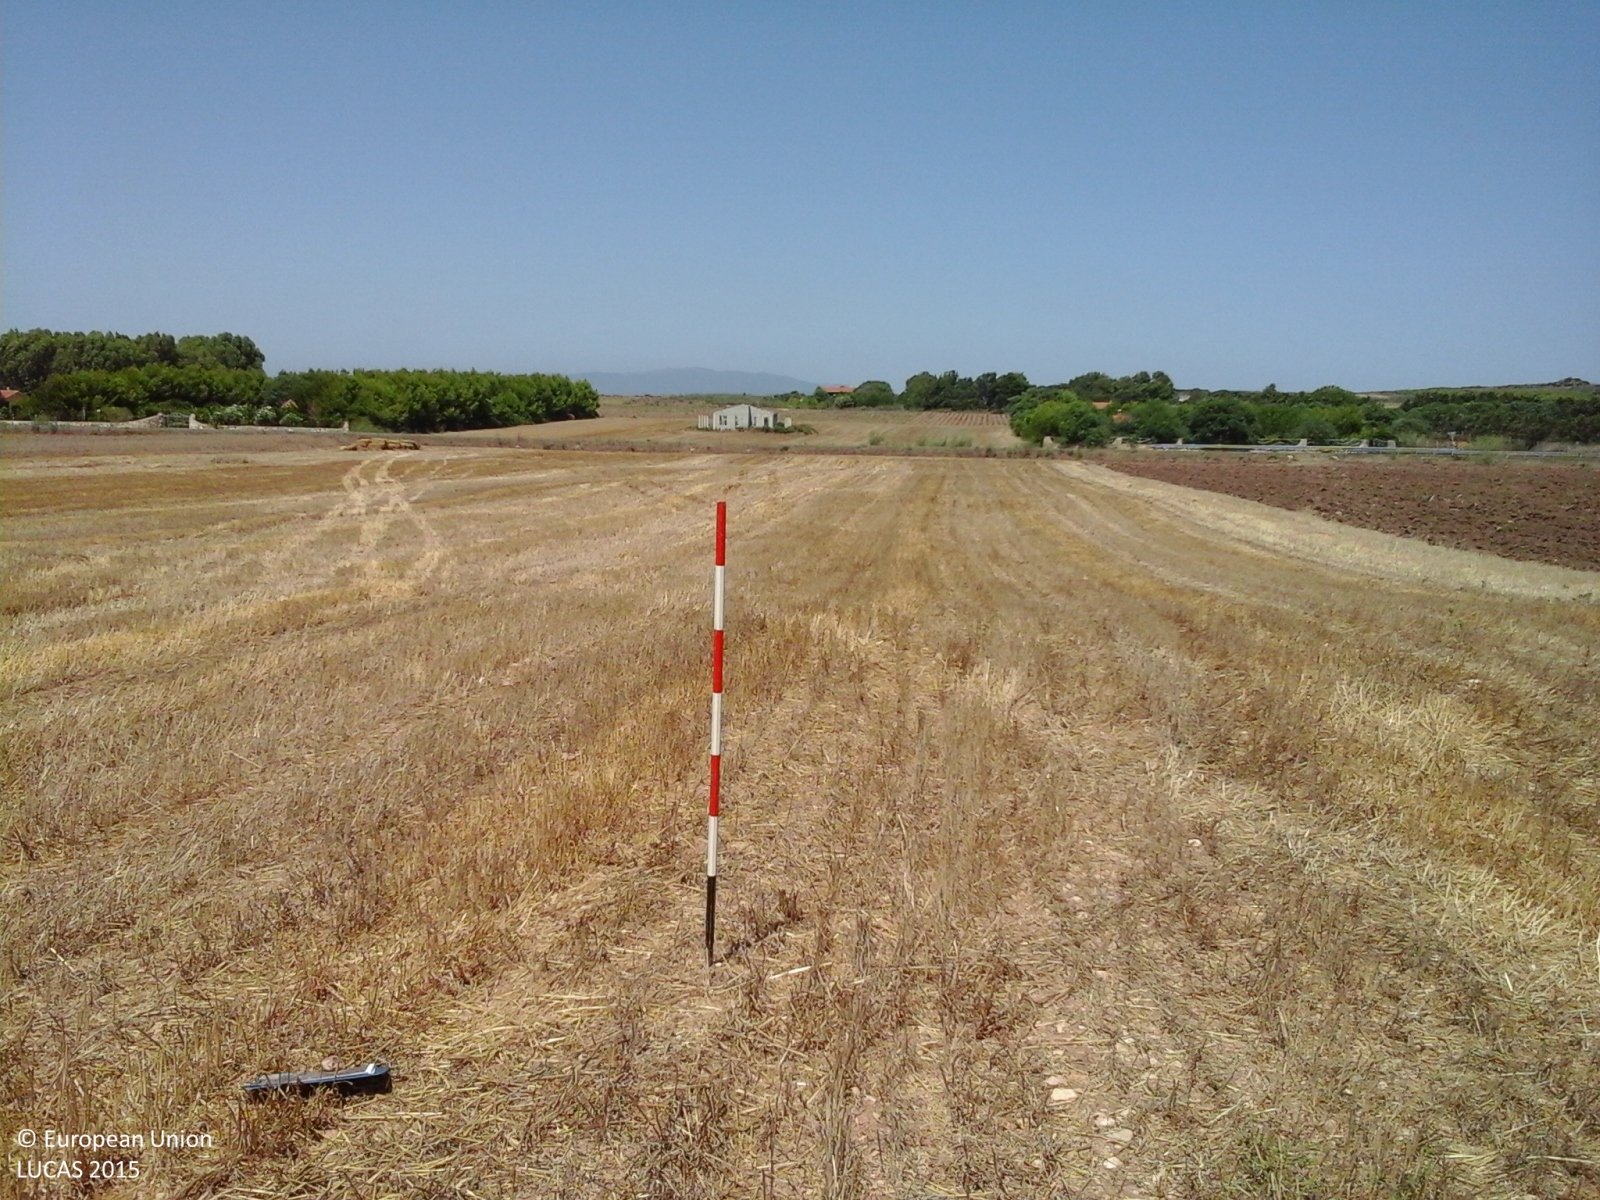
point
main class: Cropland
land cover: Durum wheat
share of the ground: > 75 %
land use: Agriculture (excluding fallow land and kitchen gardens)
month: July
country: IT
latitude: 39.9469
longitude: 8.4286
